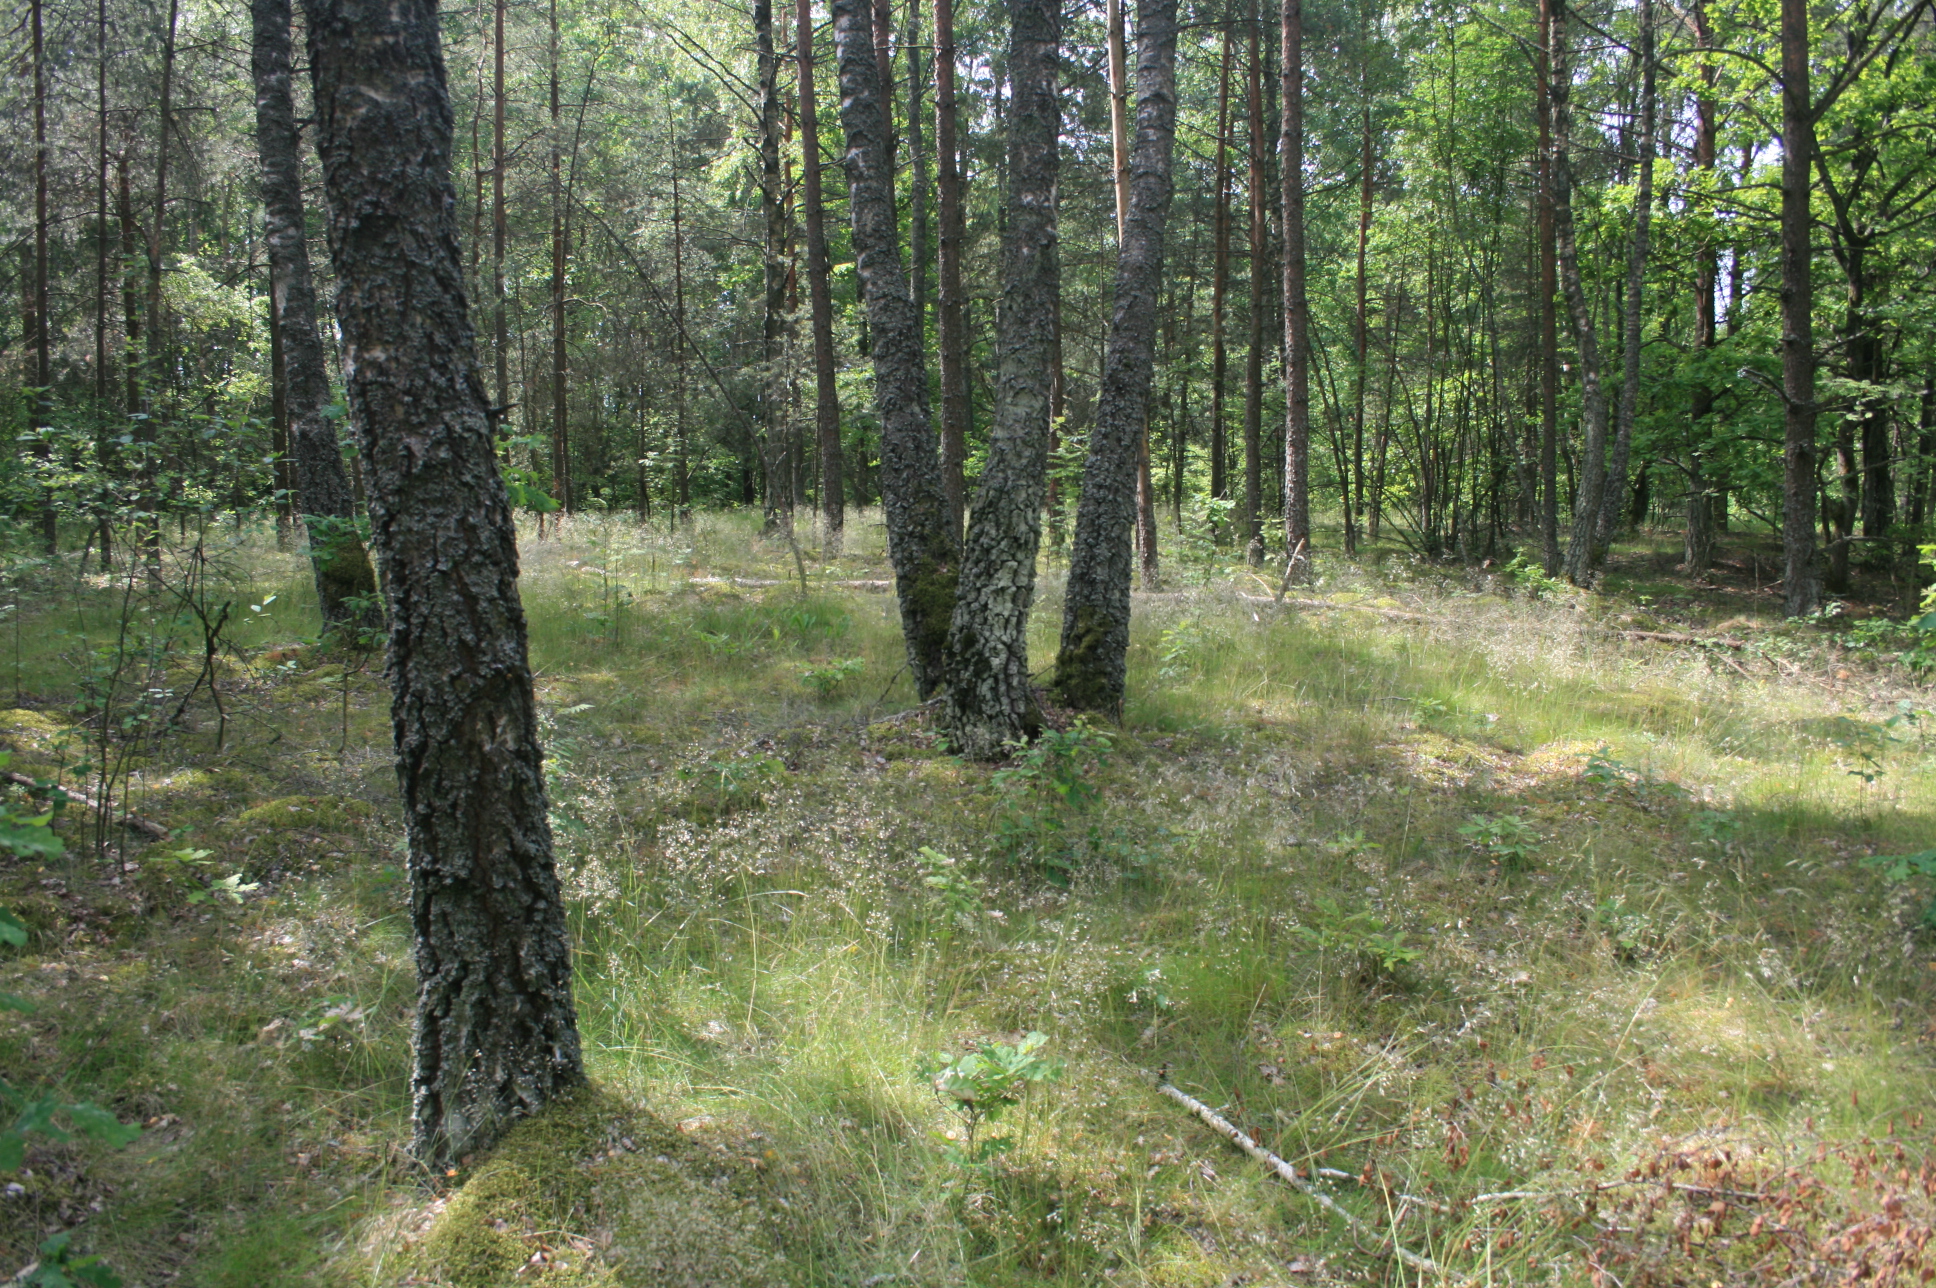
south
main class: Woodland
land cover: Pine dominated mixed woodland
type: hemiboreal forest and nemoral coniferous forest and mixed broadleaved-coniferous forest
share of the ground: > 75 %
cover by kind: coniferous forest trees 55 %, broadleaved forest trees 30 %, herbaceous plants 15 %
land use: Forestry
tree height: > 5 m
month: June
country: LT
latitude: 55.2114
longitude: 21.7267
